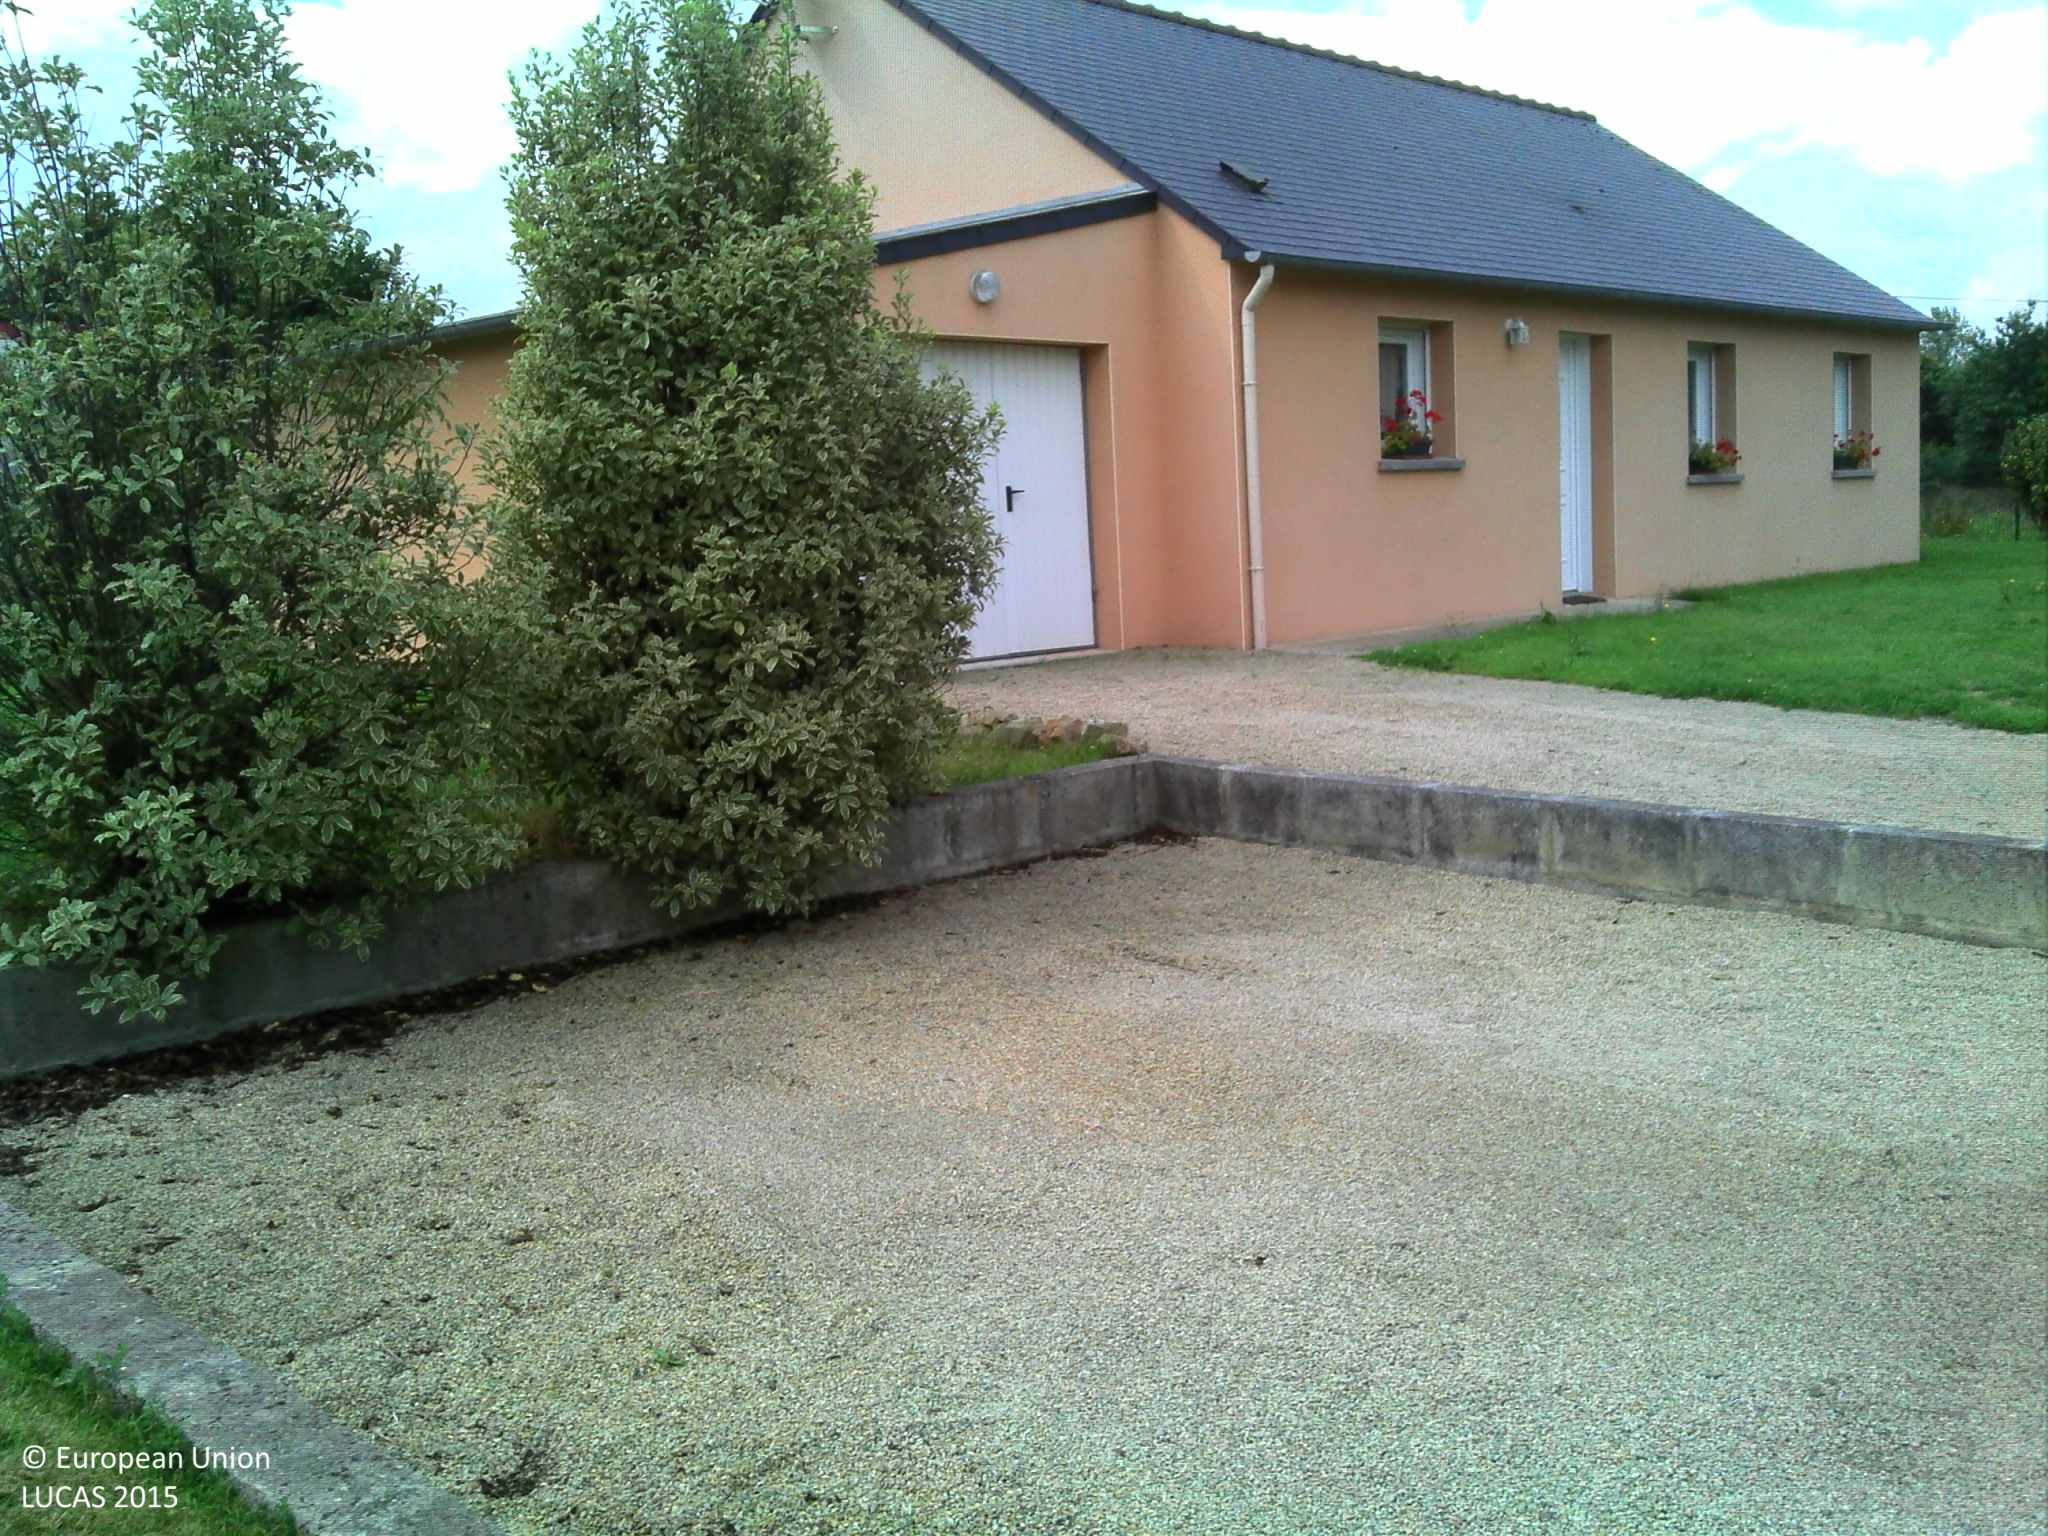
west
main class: Grassland
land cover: Grassland without tree/shrub cover
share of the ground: > 75 %
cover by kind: herbaceous plants 100 %
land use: Residential
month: August
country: FR
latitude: 48.6149
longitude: -3.1629
